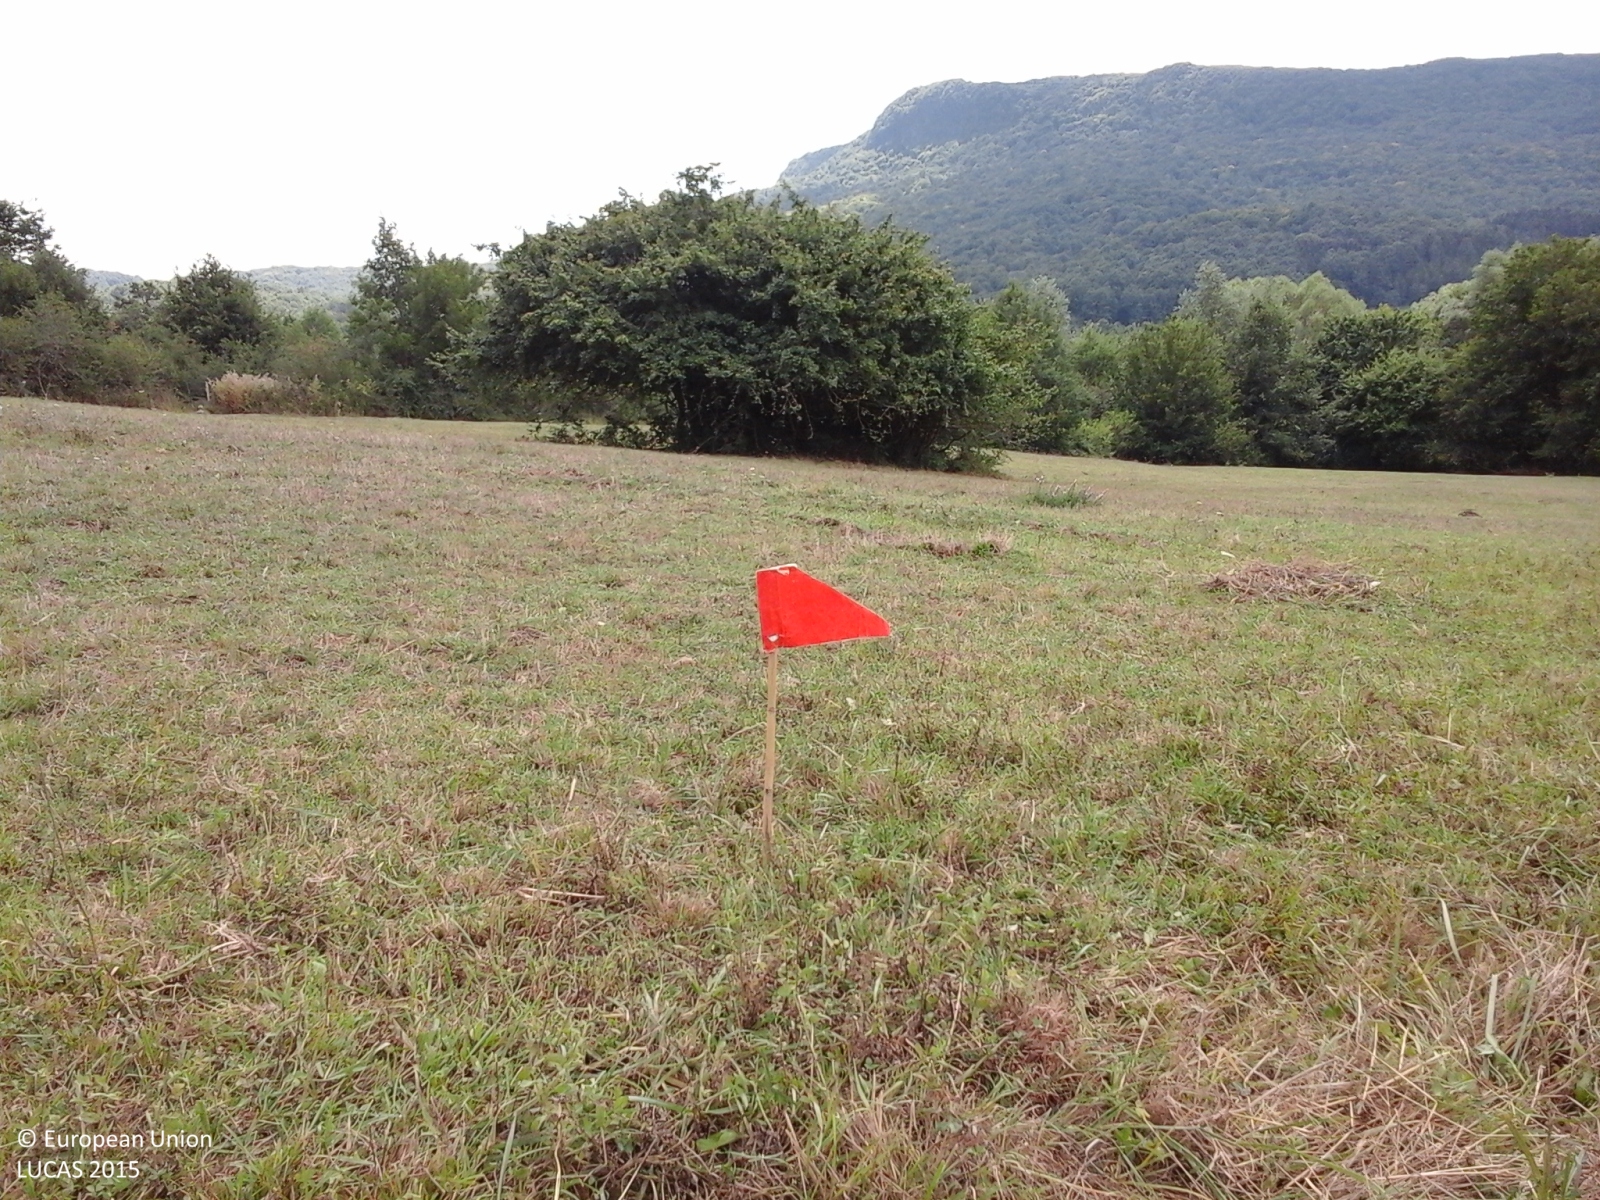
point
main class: Grassland
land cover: Grassland without tree/shrub cover
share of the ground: > 75 %
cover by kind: herbaceous plants 100 %
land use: Agriculture (excluding fallow land and kitchen gardens)
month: August
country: IT
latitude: 41.7707
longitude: 14.2079
